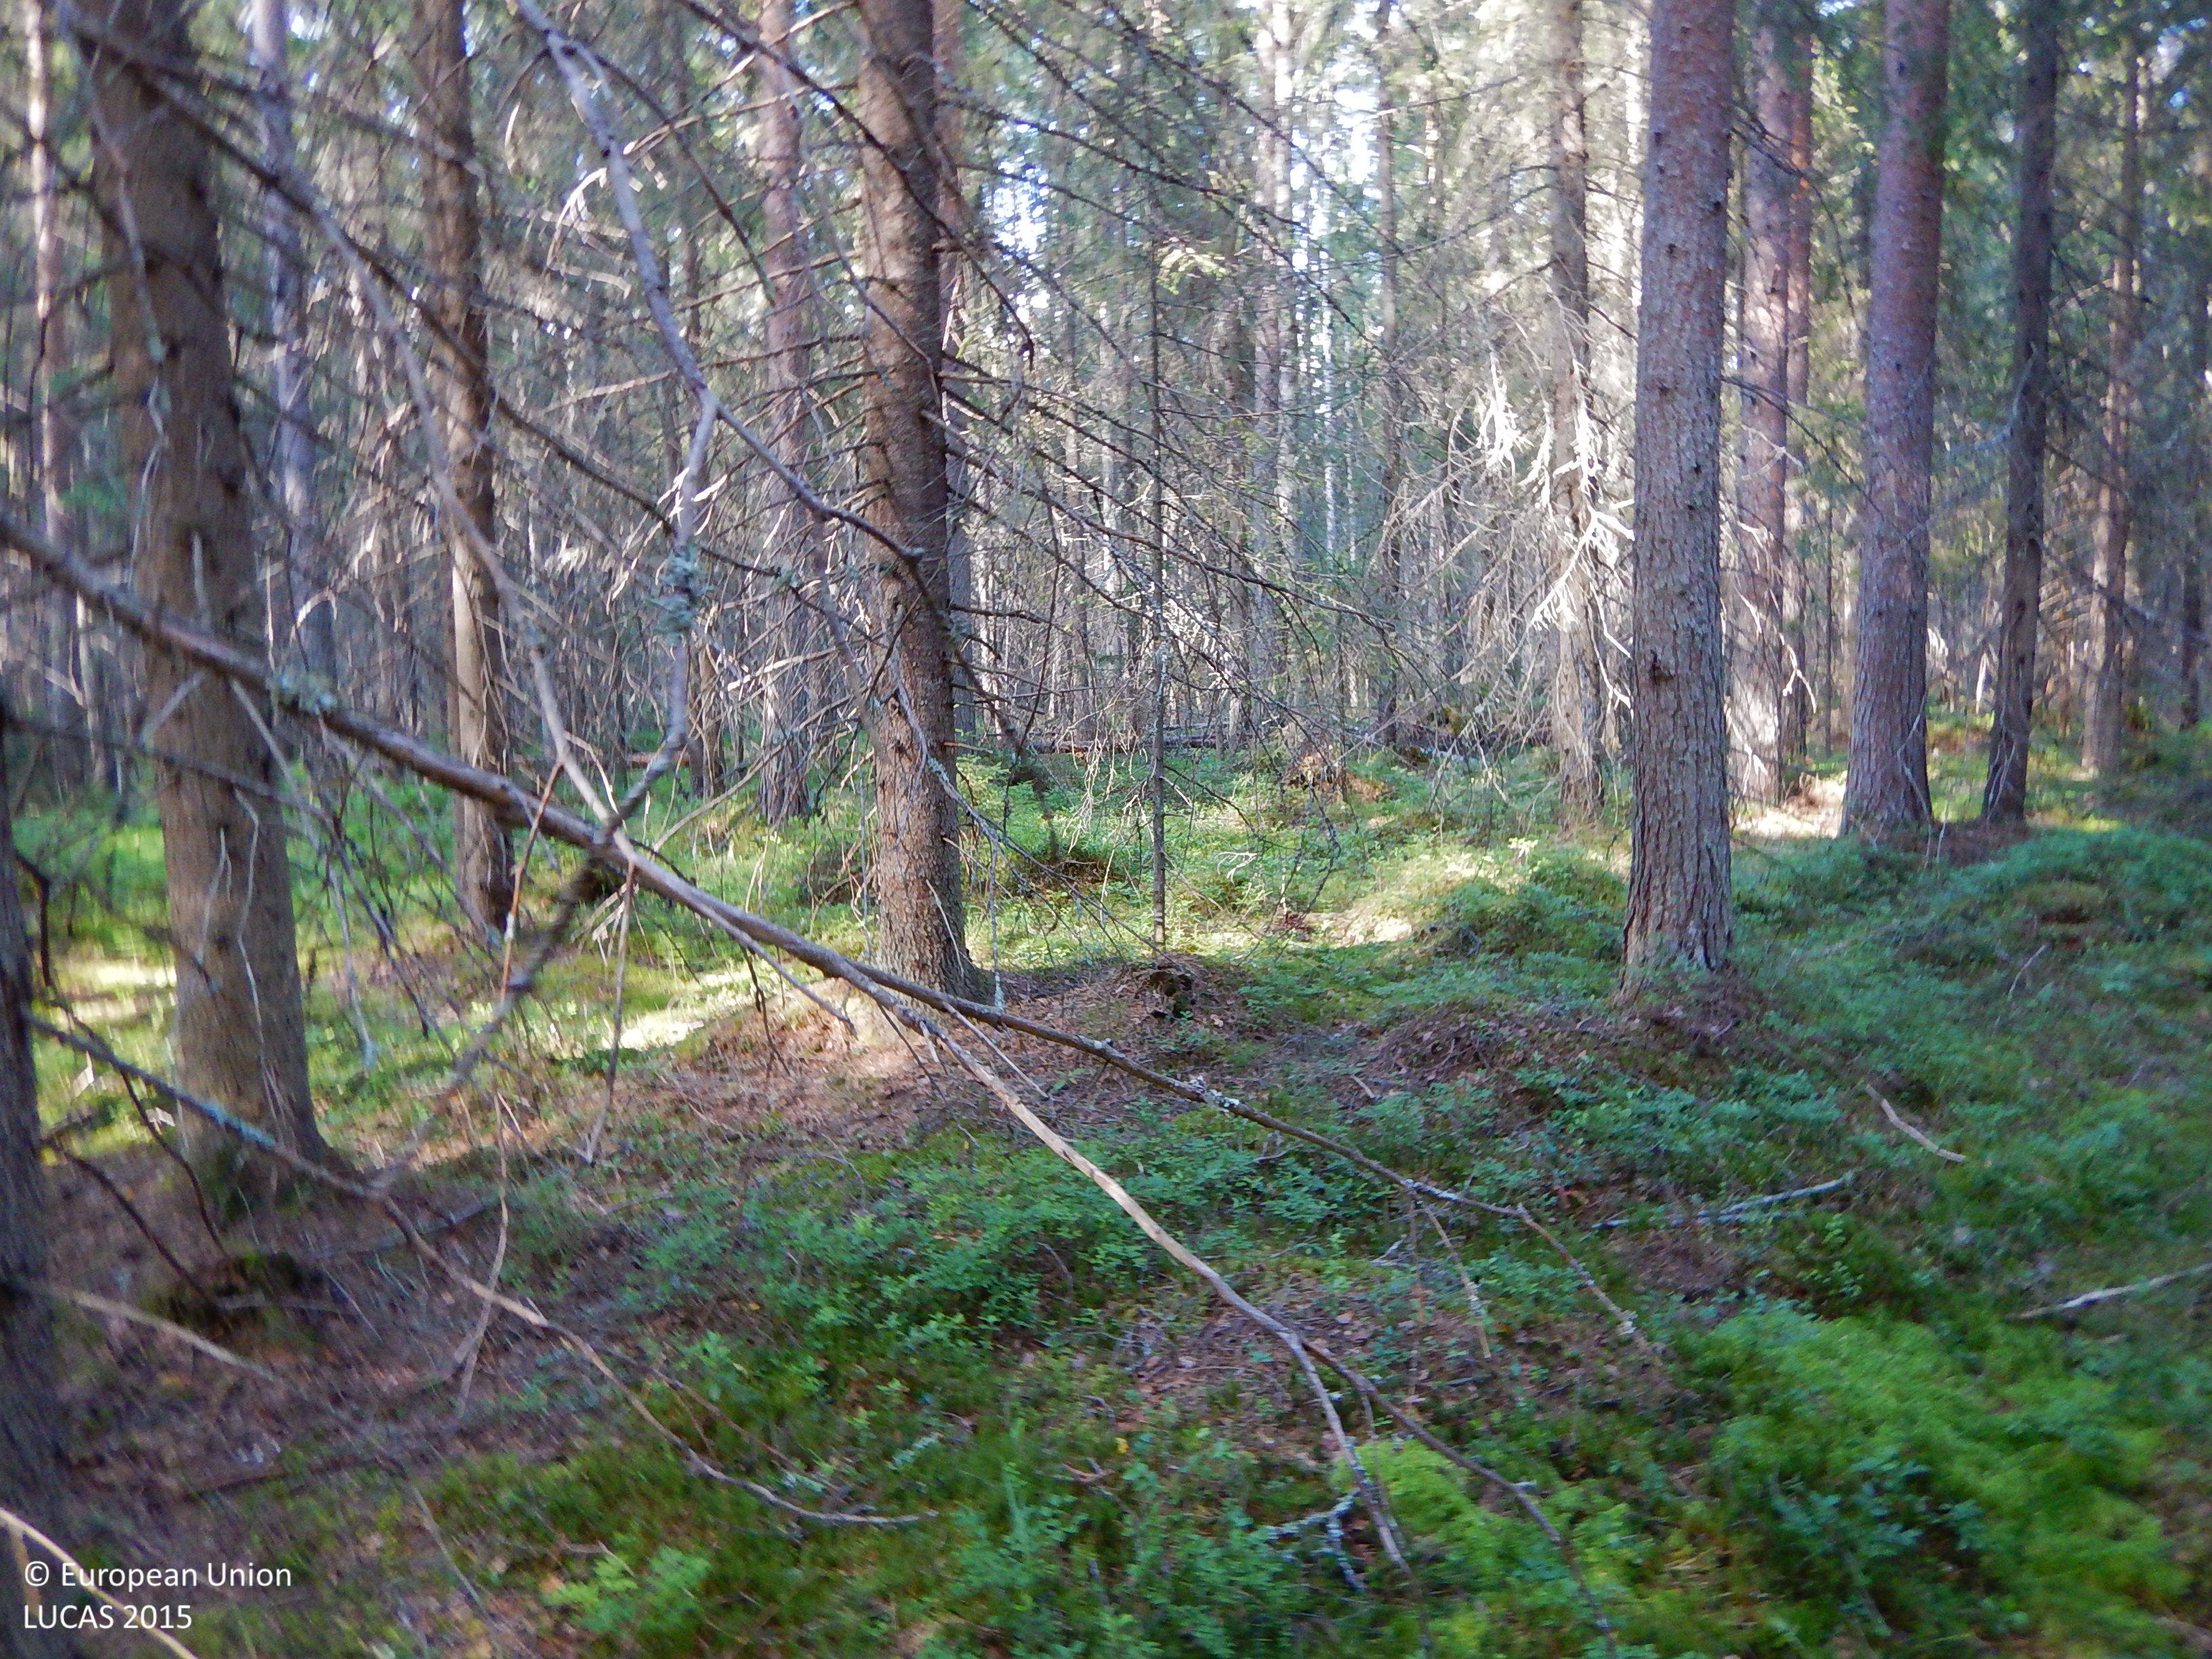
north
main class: Woodland
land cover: Spruce dominated coniferous woodland
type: boreal forest
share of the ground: 50 - 75 %
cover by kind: coniferous forest trees 55 %, lichens and mosses 20 %, broadleaved forest trees 10 %, shrubs 10 %, herbaceous plants 5 %
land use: Forestry
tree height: > 5 m
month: July
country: SE
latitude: 64.8015
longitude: 20.9872
